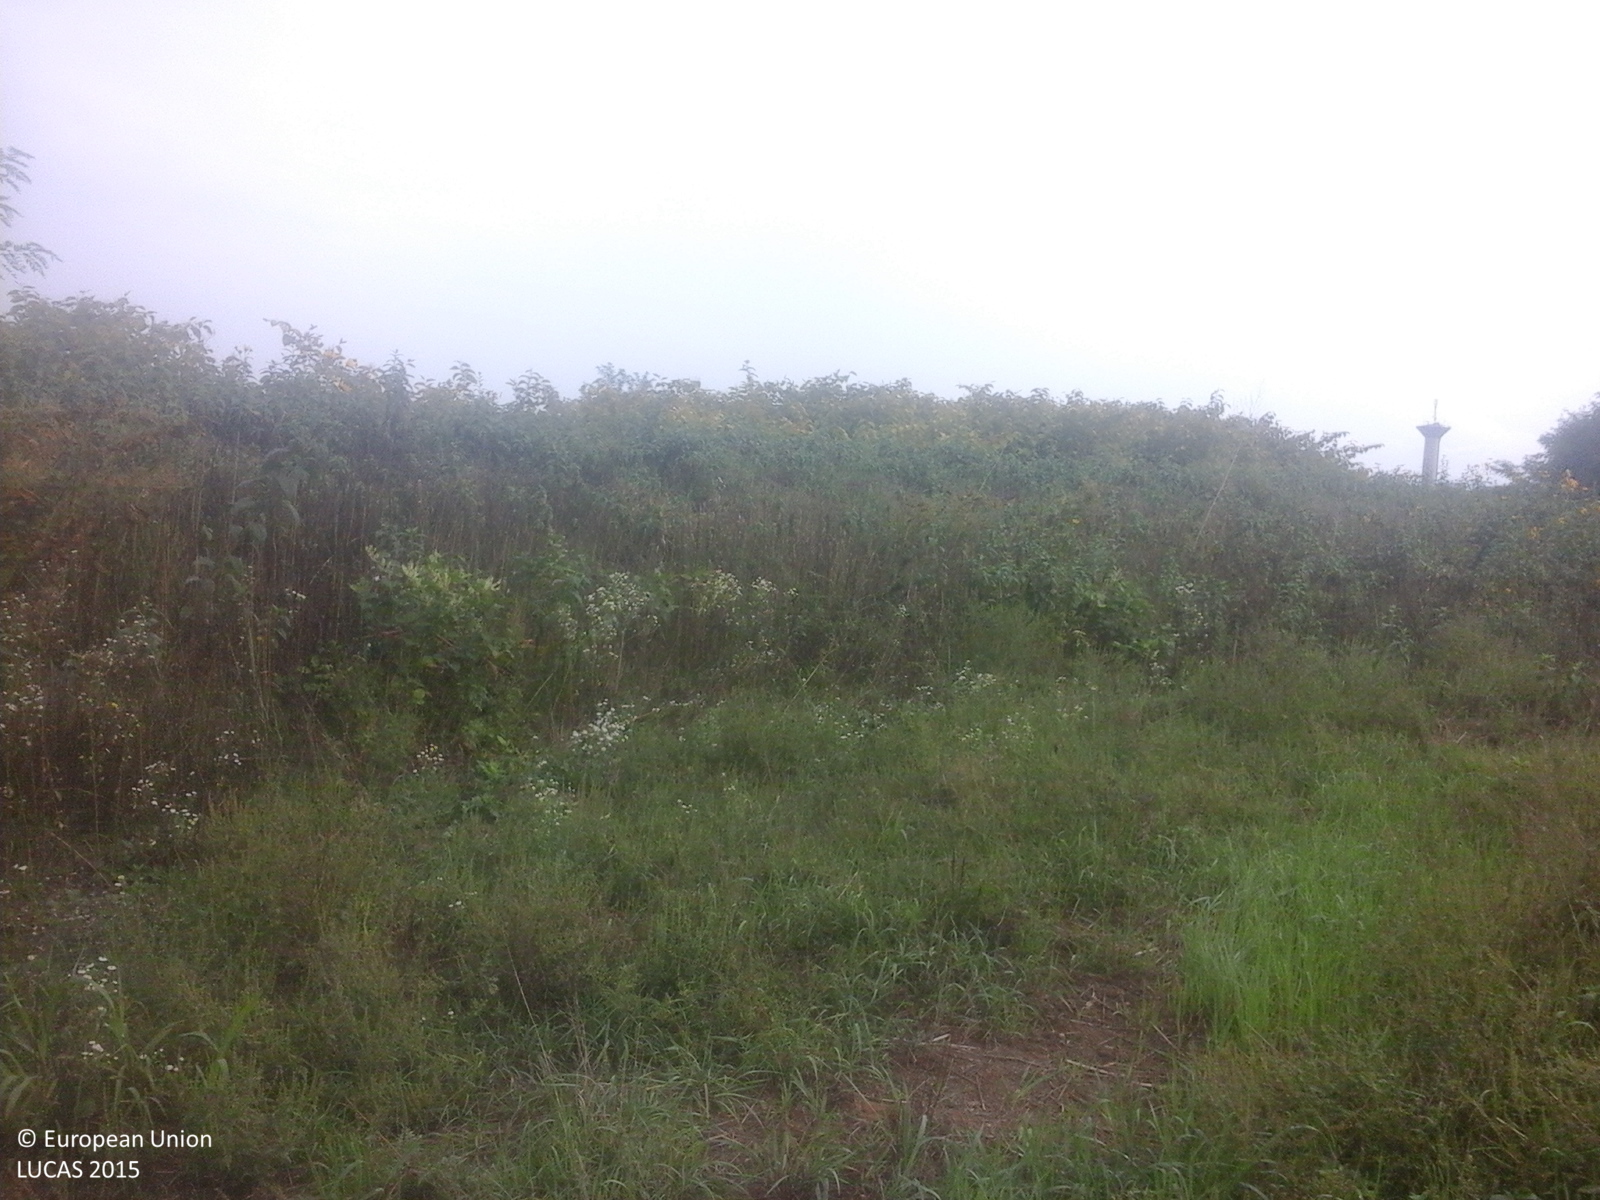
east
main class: Grassland
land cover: Spontaneously vegetated surfaces
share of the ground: > 75 %
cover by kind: herbaceous plants 100 %
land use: Fallow land
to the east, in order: Spontaneously vegetated surfaces; Tracks; Spontaneously vegetated surfaces; Inland fresh running water; Spontaneously vegetated surfaces; Abandoned hedges; Spontaneously vegetated surfaces; Abandoned hedges; Inland fresh running water; Abandoned hedges
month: September
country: RO
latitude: 45.8546
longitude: 22.1617
